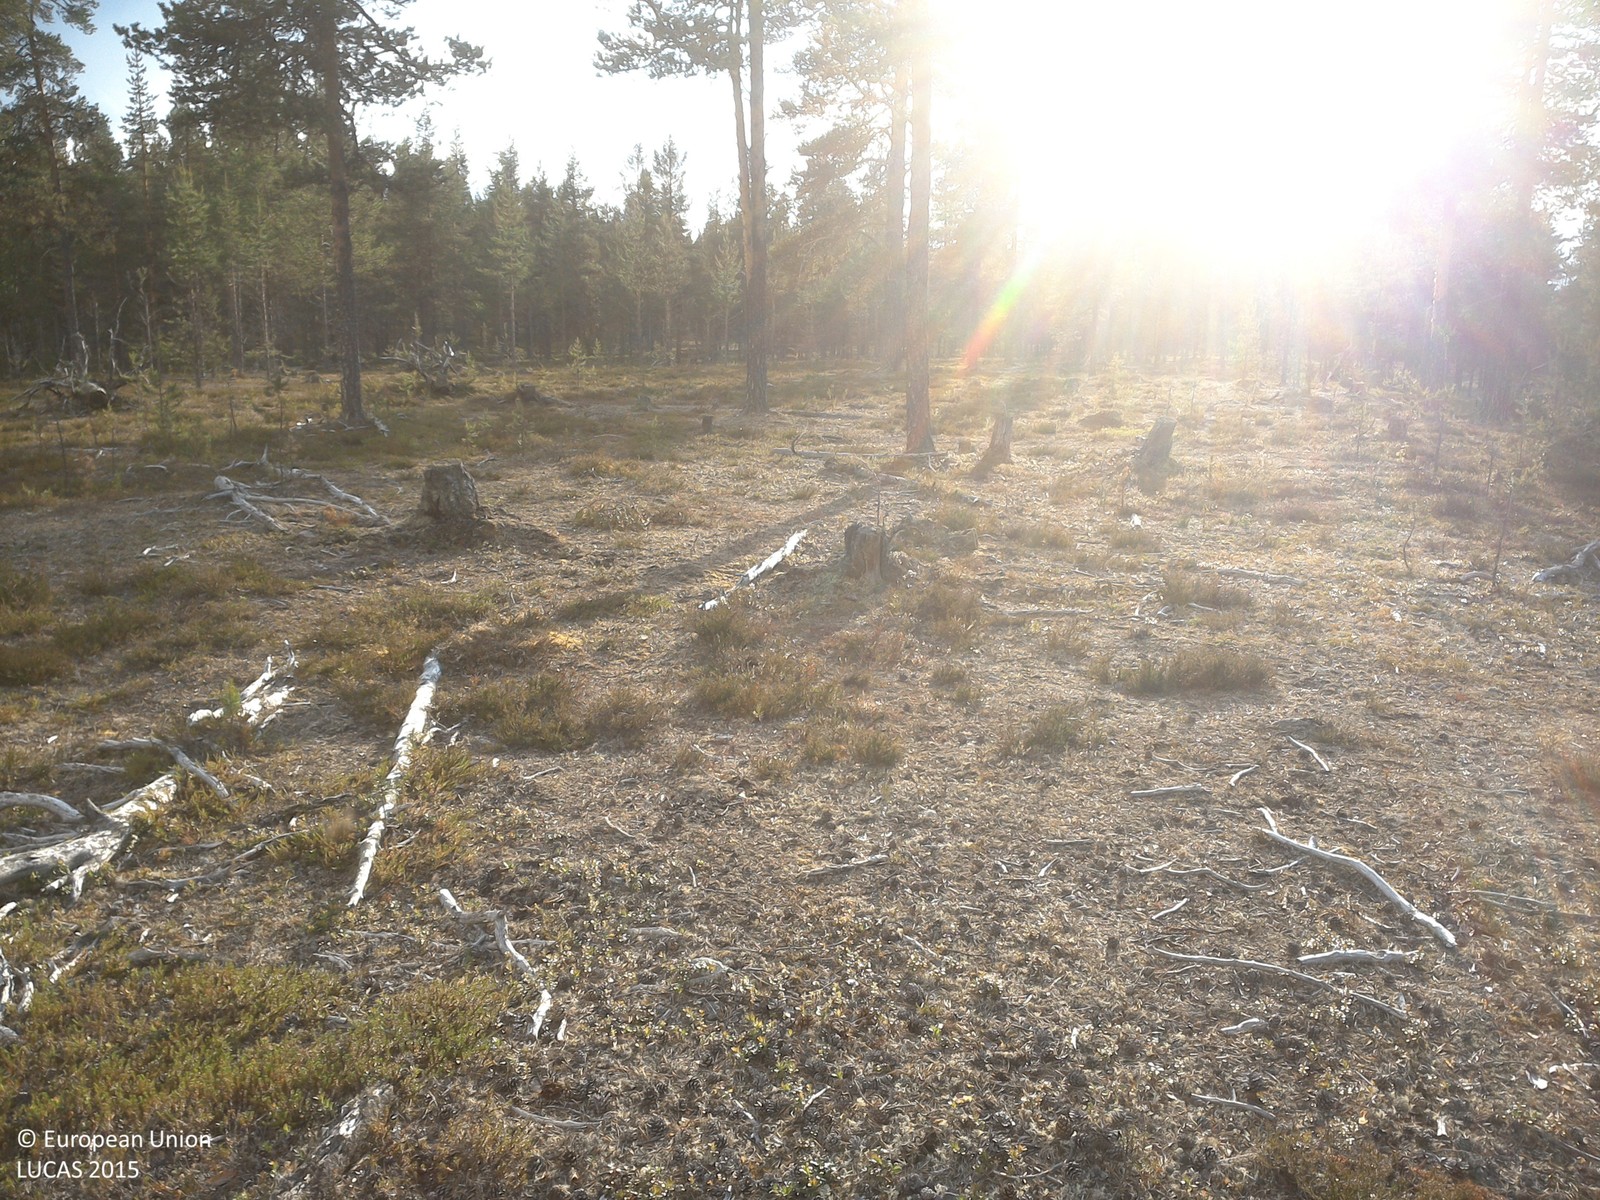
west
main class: Woodland
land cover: Pine dominated coniferous woodland
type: boreal forest
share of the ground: 10 - 25 %
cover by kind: lichens and mosses 45 %, shrubs 35 %, coniferous forest trees 20 %
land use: Forestry
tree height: > 5 m
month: July
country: SE
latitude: 67.7465
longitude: 23.4282
